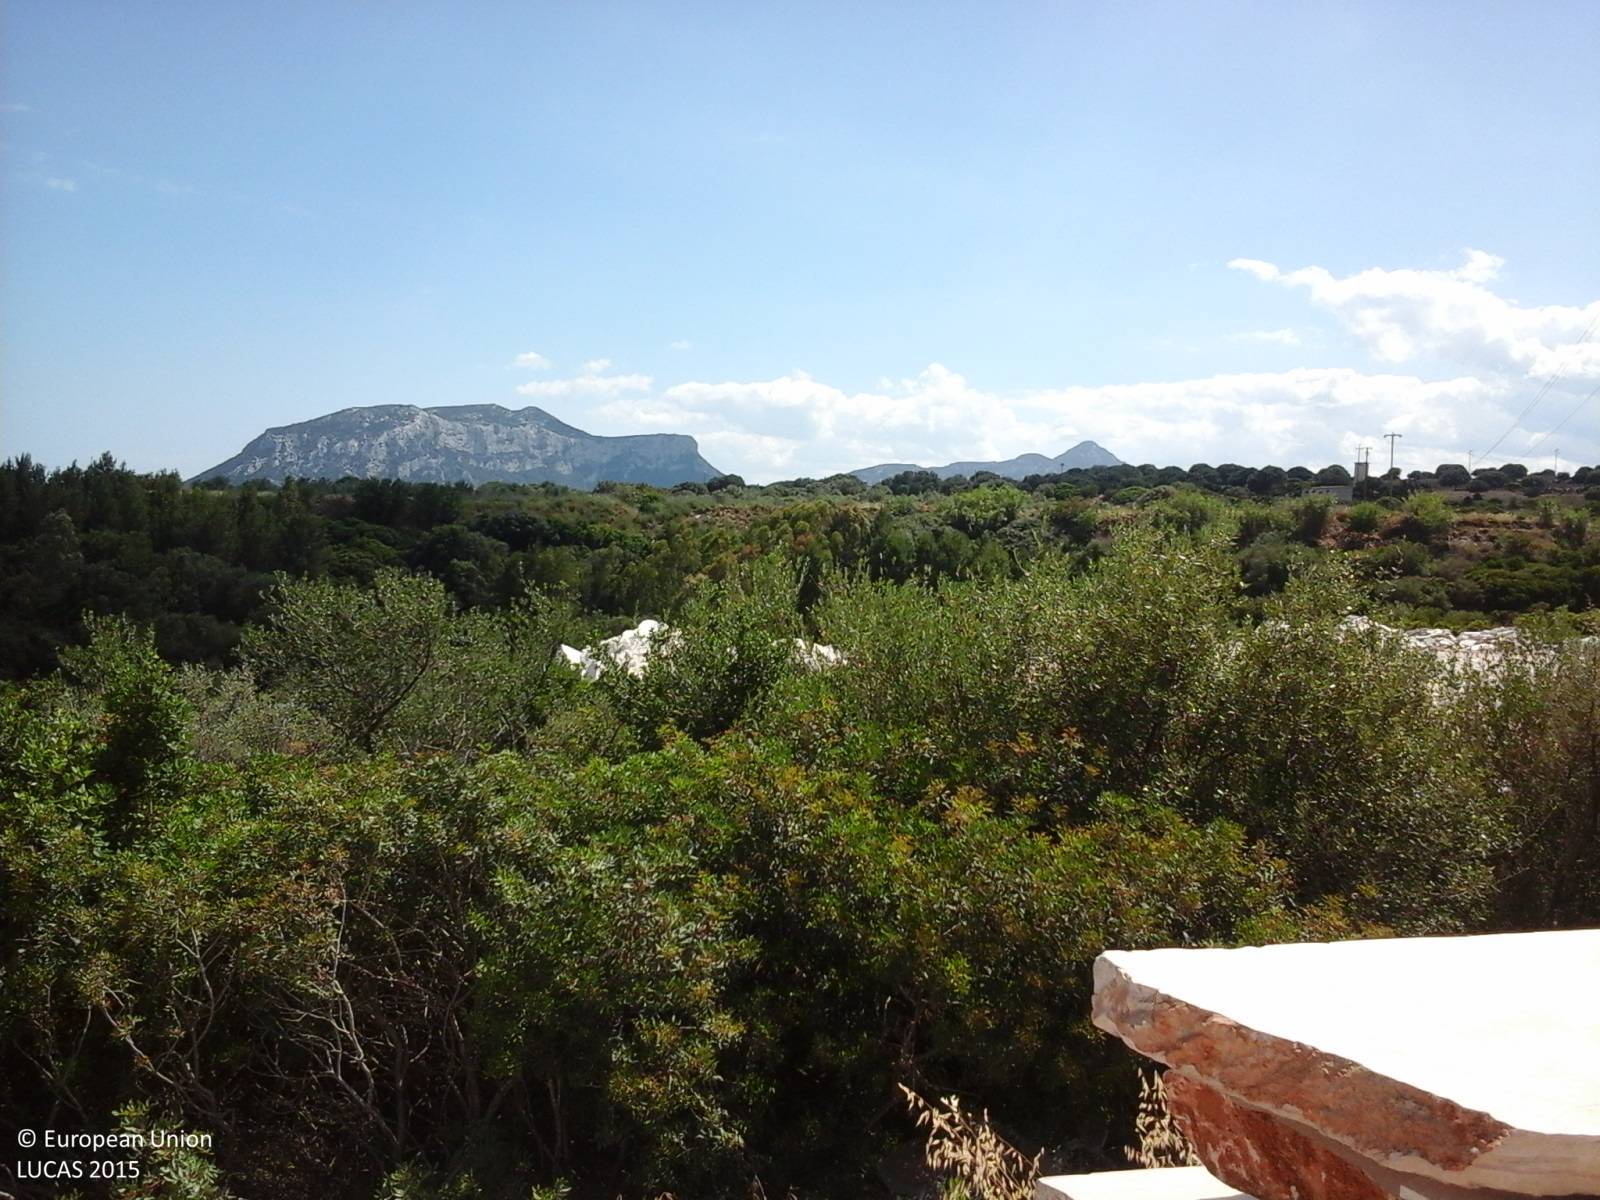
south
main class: Woodland
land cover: Broadleaved woodland
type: broadleaved evergreen forest
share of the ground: > 75 %
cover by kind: broadleaved forest trees 95 %, shrubs 5 %
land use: Forestry
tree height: > 5 m
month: June
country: IT
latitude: 40.3573
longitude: 9.6603
